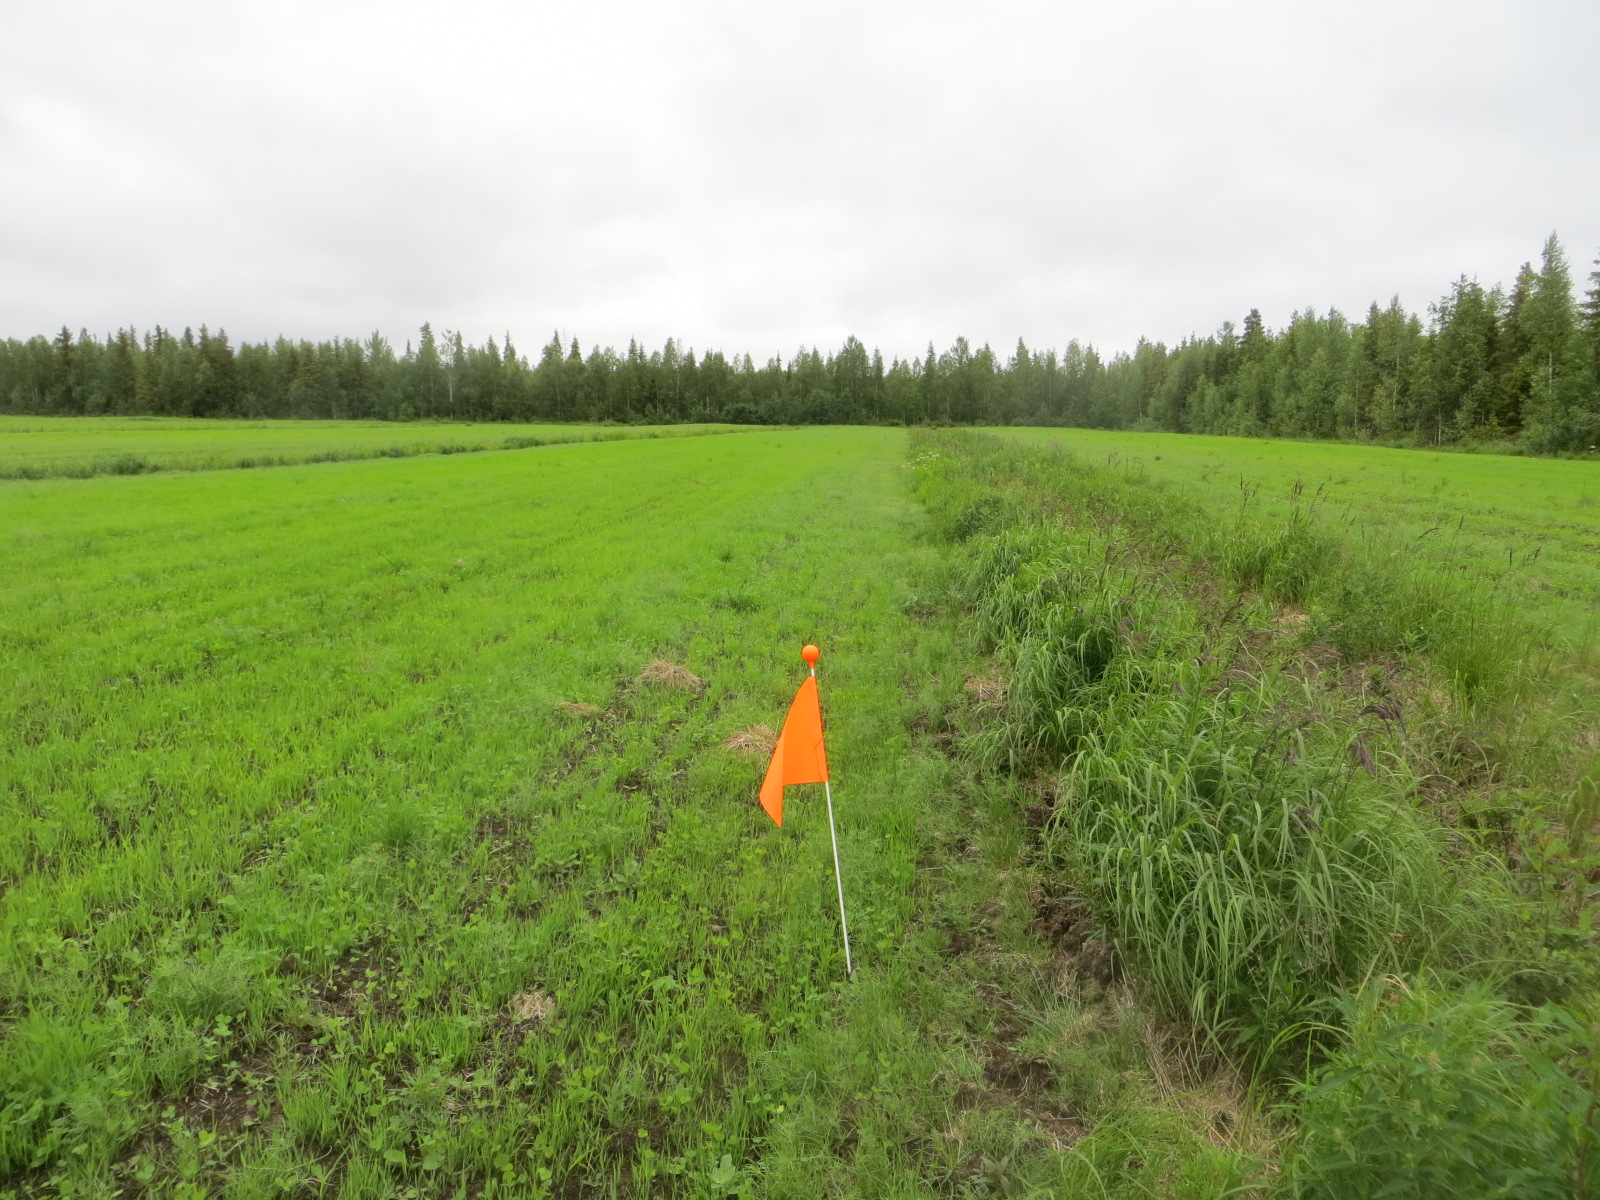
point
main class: Cropland
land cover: Temporary grasslands
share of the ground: 25 - 50 %
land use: Agriculture (excluding fallow land and kitchen gardens)
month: July
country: FI
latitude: 66.3943
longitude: 24.3892
